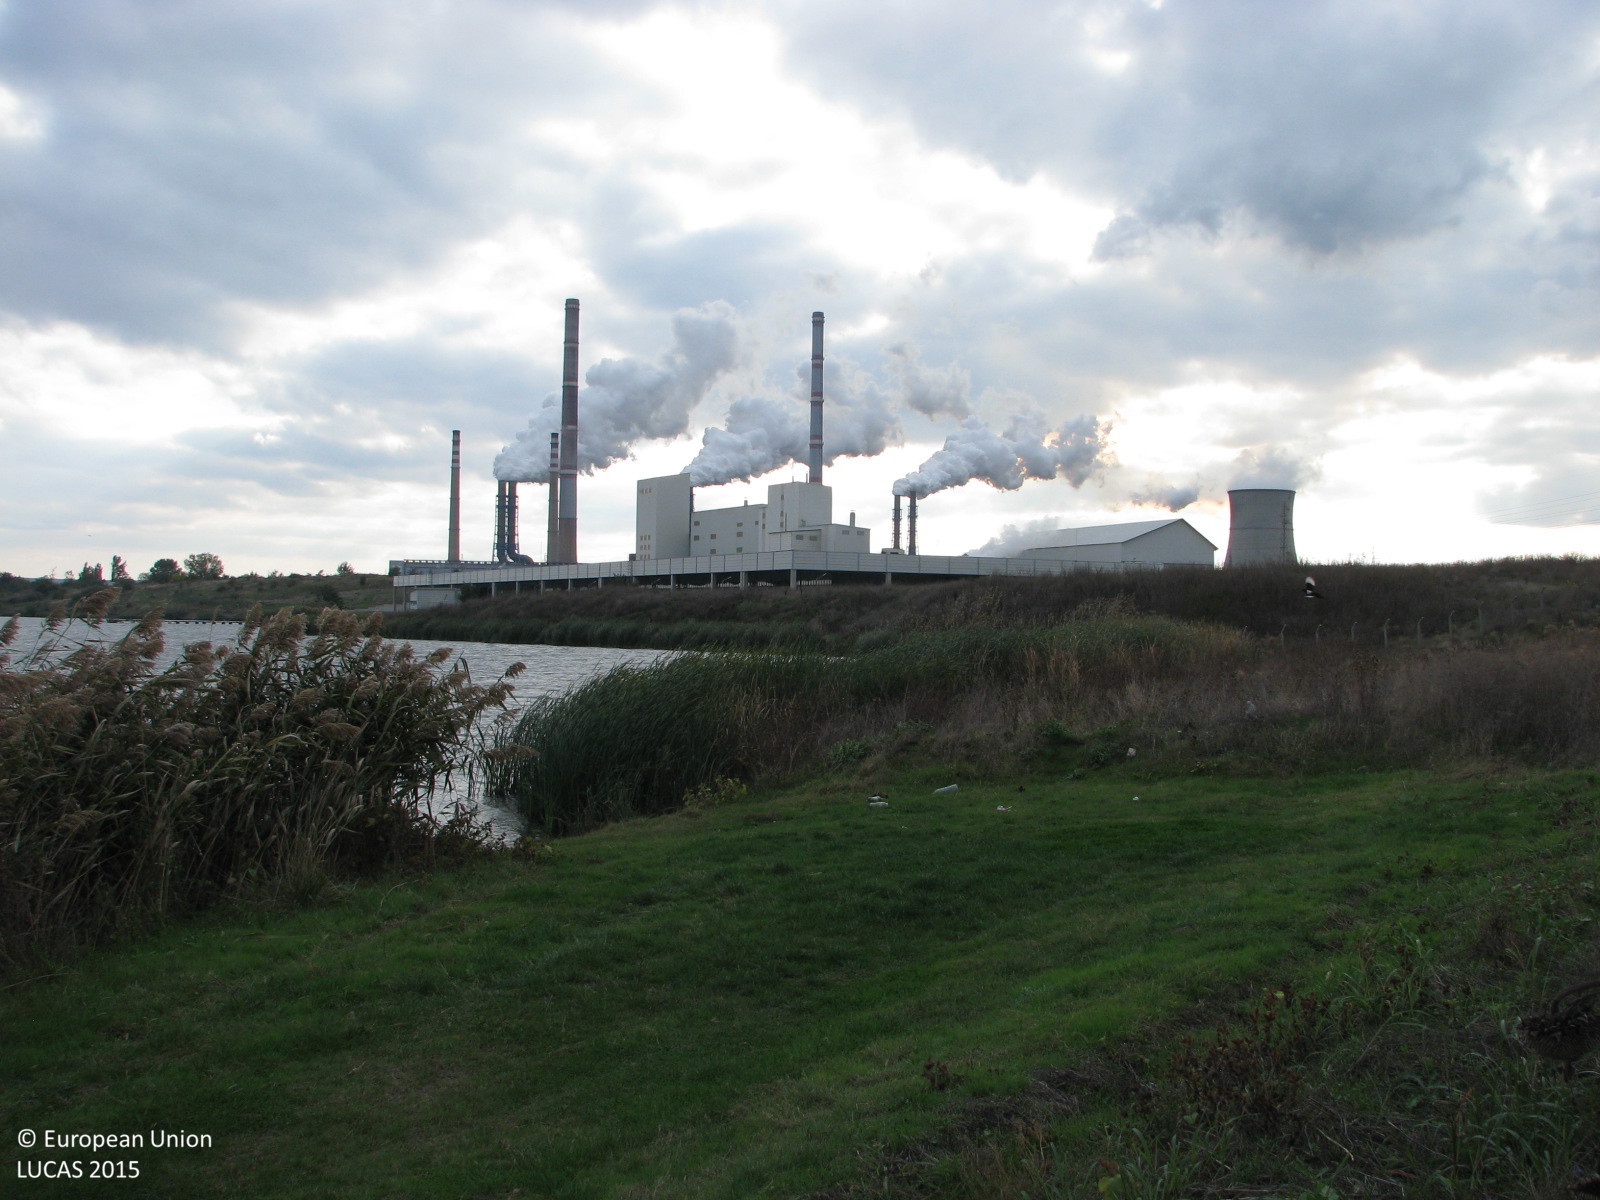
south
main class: Cropland
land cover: Sunflower
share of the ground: 50 - 75 %
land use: Agriculture (excluding fallow land and kitchen gardens)
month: October
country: BG
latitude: 42.2678
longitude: 26.1451
